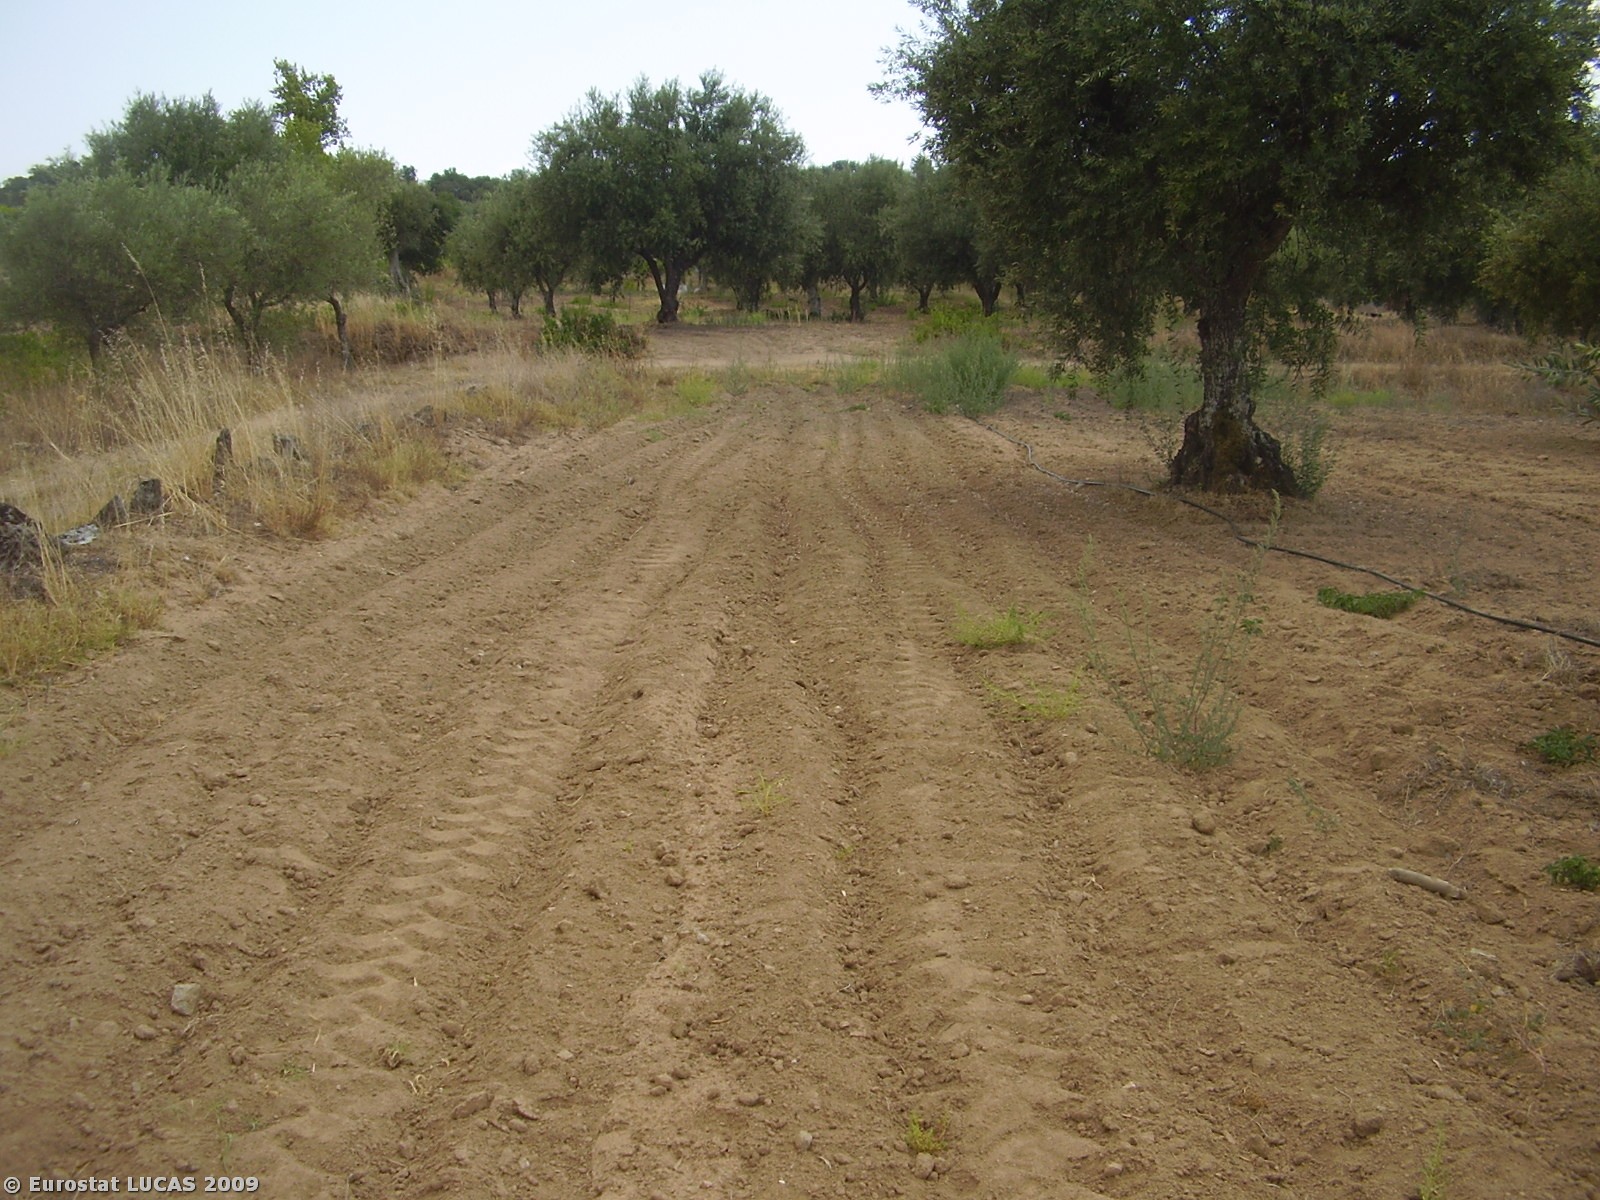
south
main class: Cropland
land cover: Olive groves
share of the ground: 10 - 25 %
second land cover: Bare land
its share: > 75 %
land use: Agriculture (excluding fallow land and kitchen gardens)
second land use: Fallow land
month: August
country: PT
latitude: 38.2205
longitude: -7.8853
